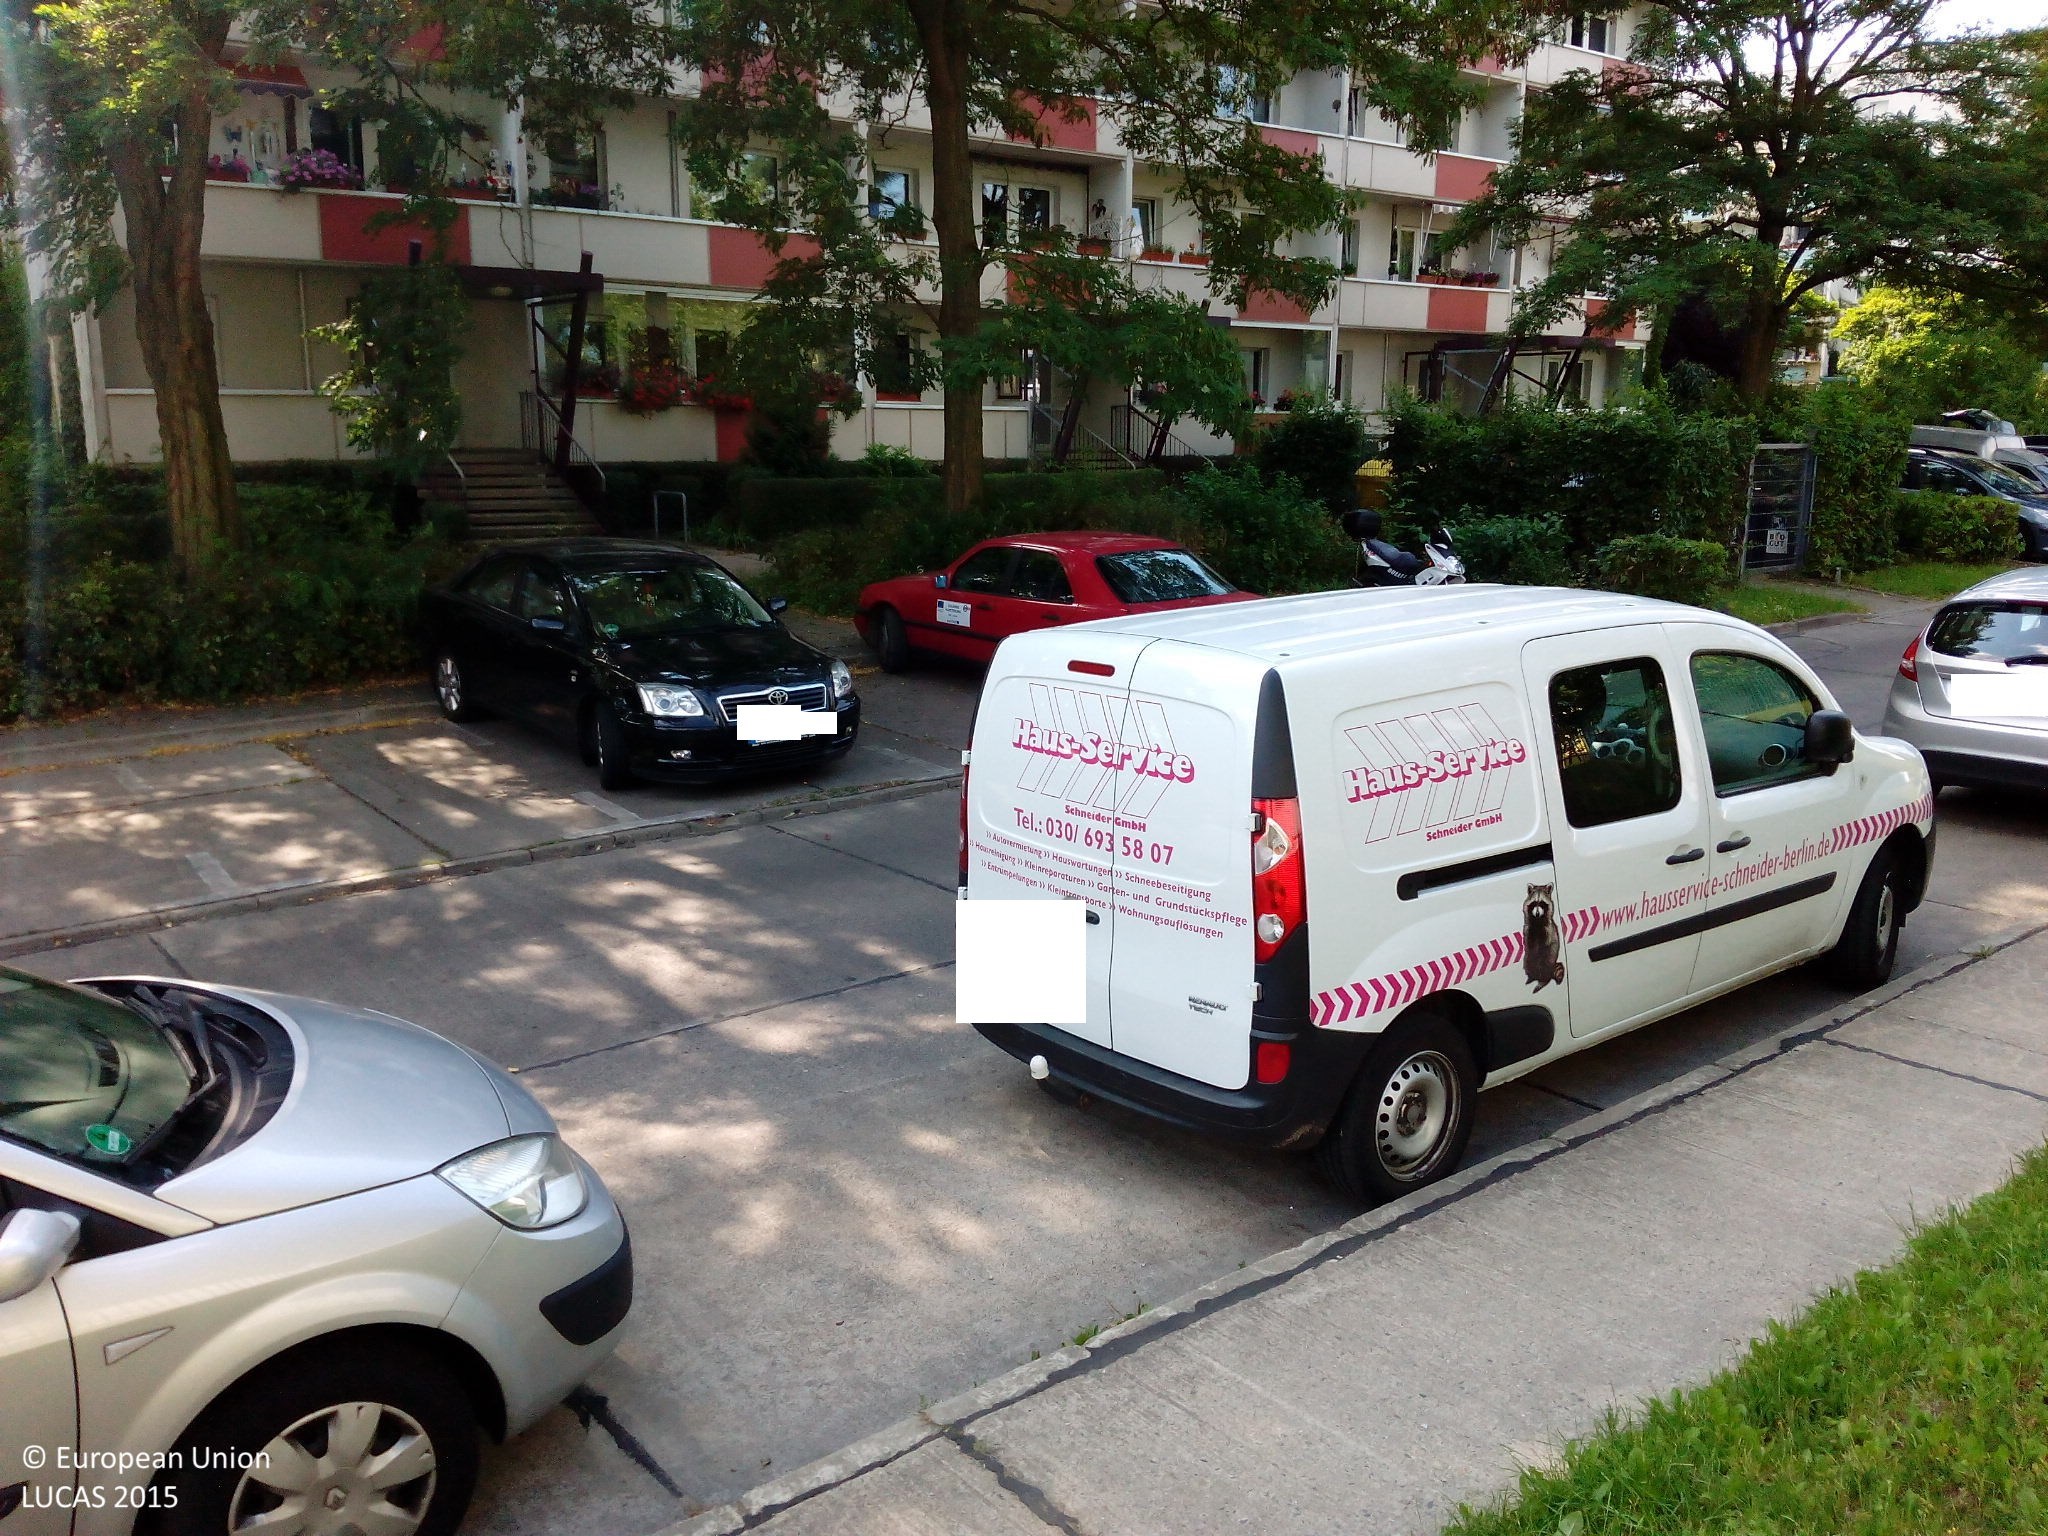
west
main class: Grassland
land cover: Grassland without tree/shrub cover
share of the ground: > 75 %
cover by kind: consolidated bare surface 75 %, herbaceous plants 25 %
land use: Semi-natural and natural areas not in use
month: July
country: DE
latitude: 52.5385
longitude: 13.6125
